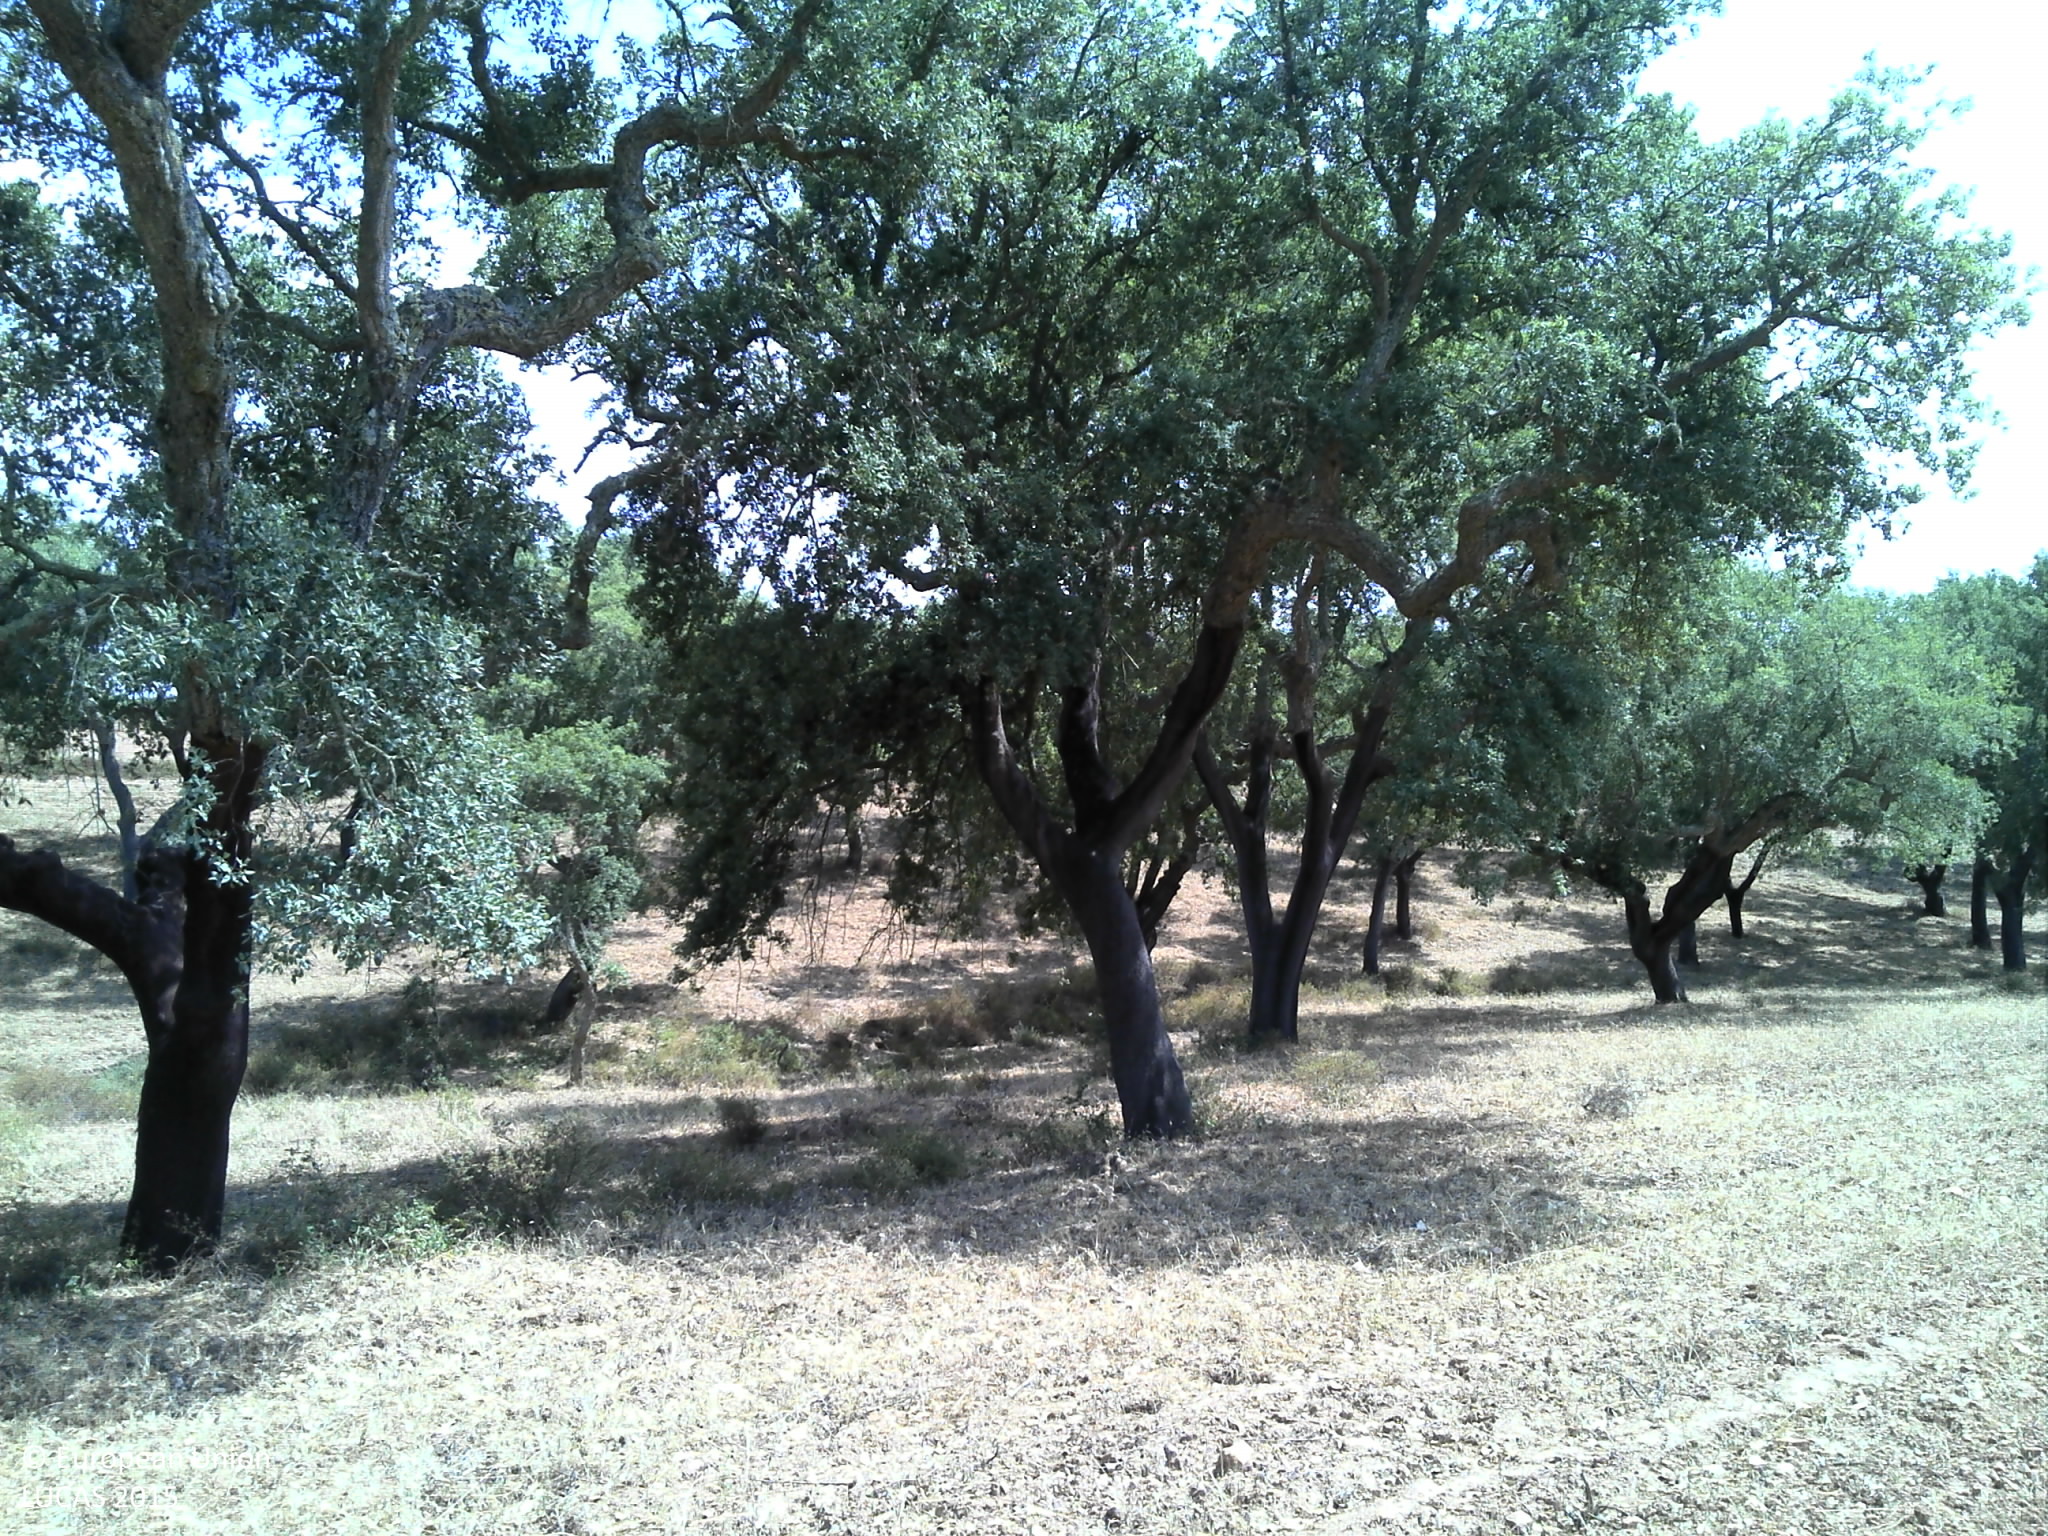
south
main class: Woodland
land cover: Broadleaved woodland
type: broadleaved evergreen forest
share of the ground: 10 - 25 %
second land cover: Grassland without tree/shrub cover
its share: 10 - 25 %
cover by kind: unconsolidated bare surface 70 %, broadleaved forest trees 15 %, herbaceous plants 15 %
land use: Forestry
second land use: Agriculture (excluding fallow land and kitchen gardens)
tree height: > 5 m
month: June
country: PT
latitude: 38.6268
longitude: -7.6902
